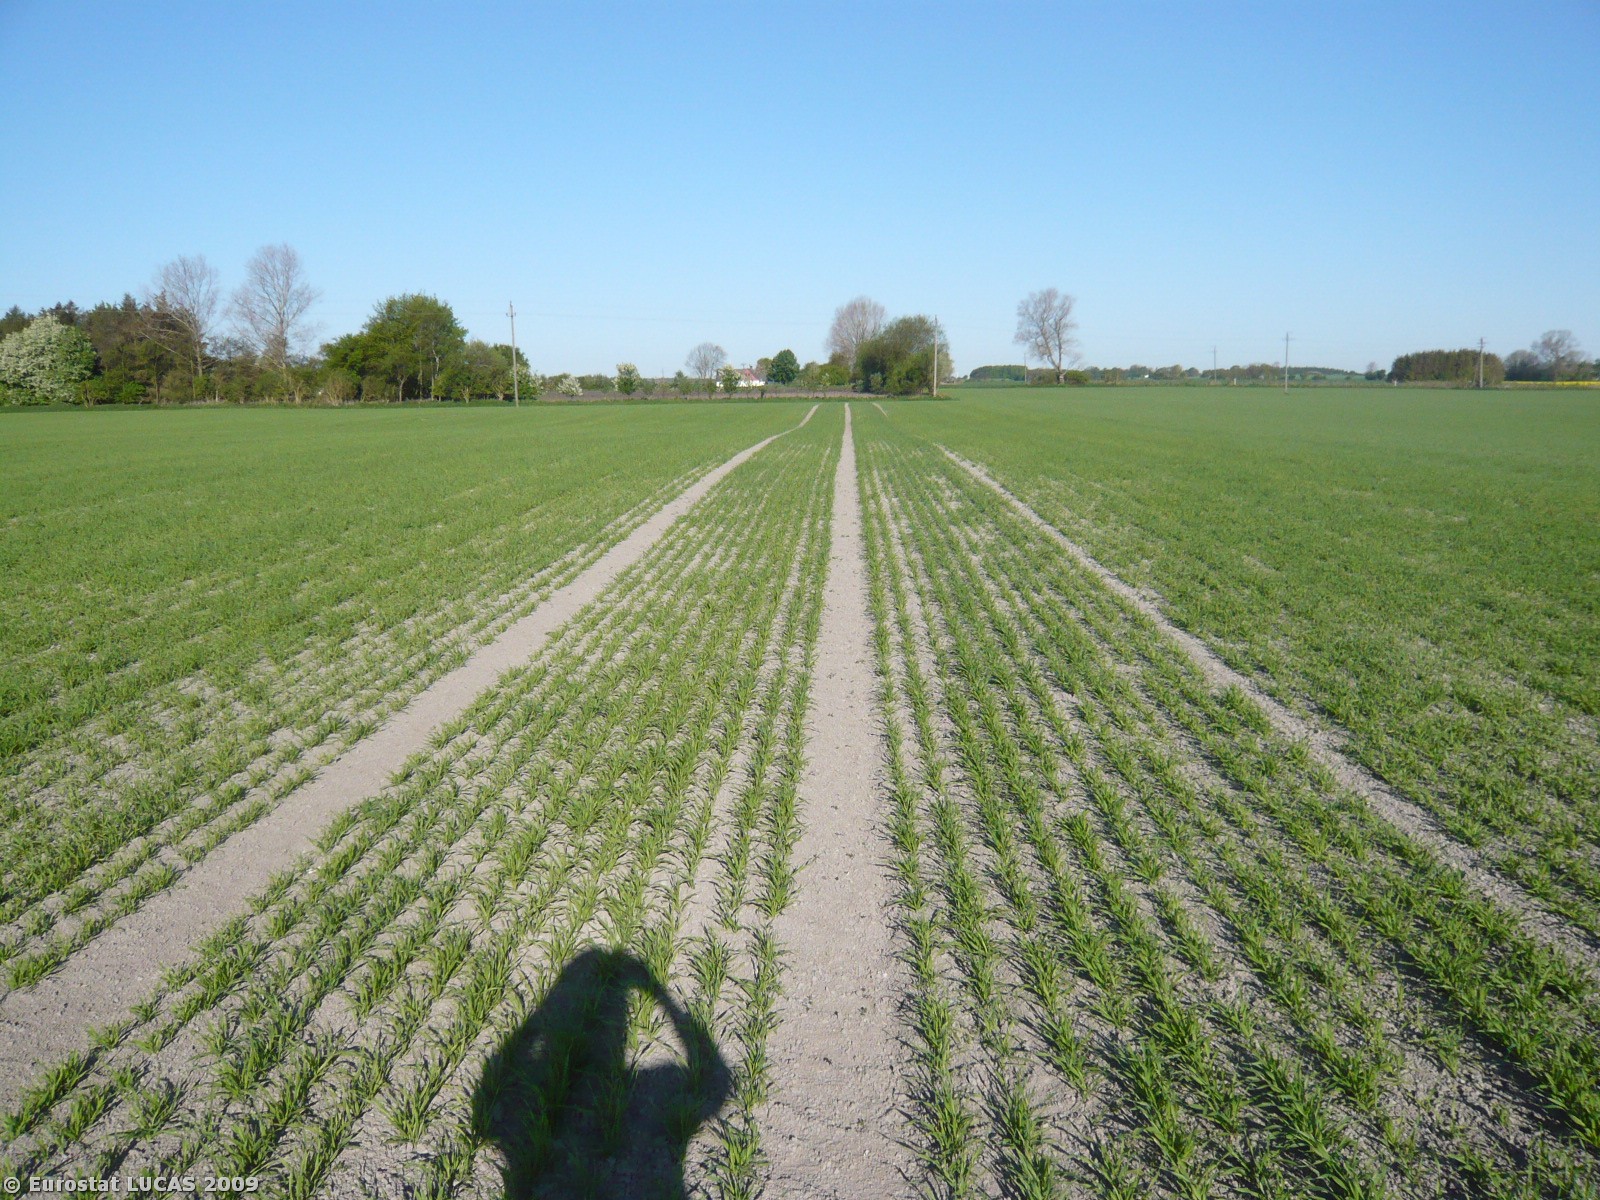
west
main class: Cropland
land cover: Common wheat
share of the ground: 25 - 50 %
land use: Agriculture (excluding fallow land and kitchen gardens)
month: May
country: DK
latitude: 55.0910
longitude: 12.1451
